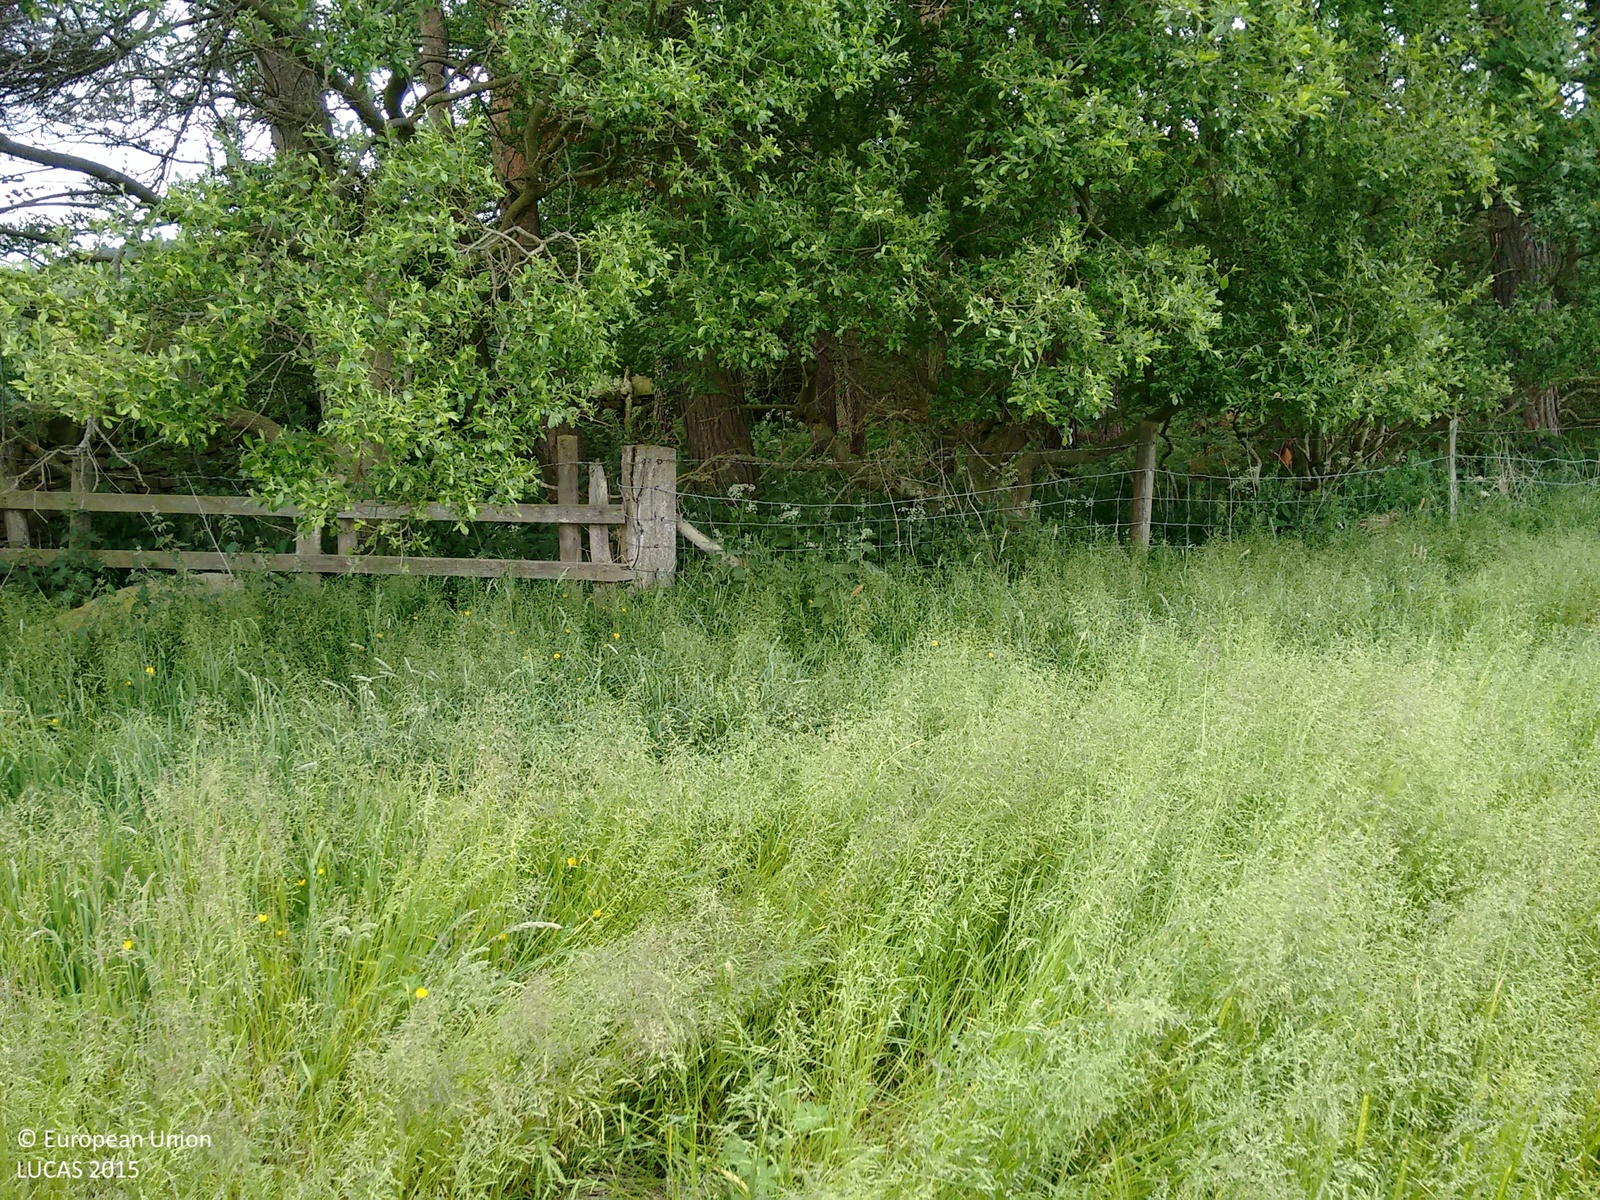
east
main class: Grassland
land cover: Grassland without tree/shrub cover
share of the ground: > 75 %
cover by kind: herbaceous plants 100 %
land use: Agriculture (excluding fallow land and kitchen gardens)
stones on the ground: < 10 %
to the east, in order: Grassland without tree/shrub cover; Fences; Dry stone walls; Grassland without tree/shrub cover; Broadleaved woodland
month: June
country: GB
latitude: 54.7869
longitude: -1.7927
